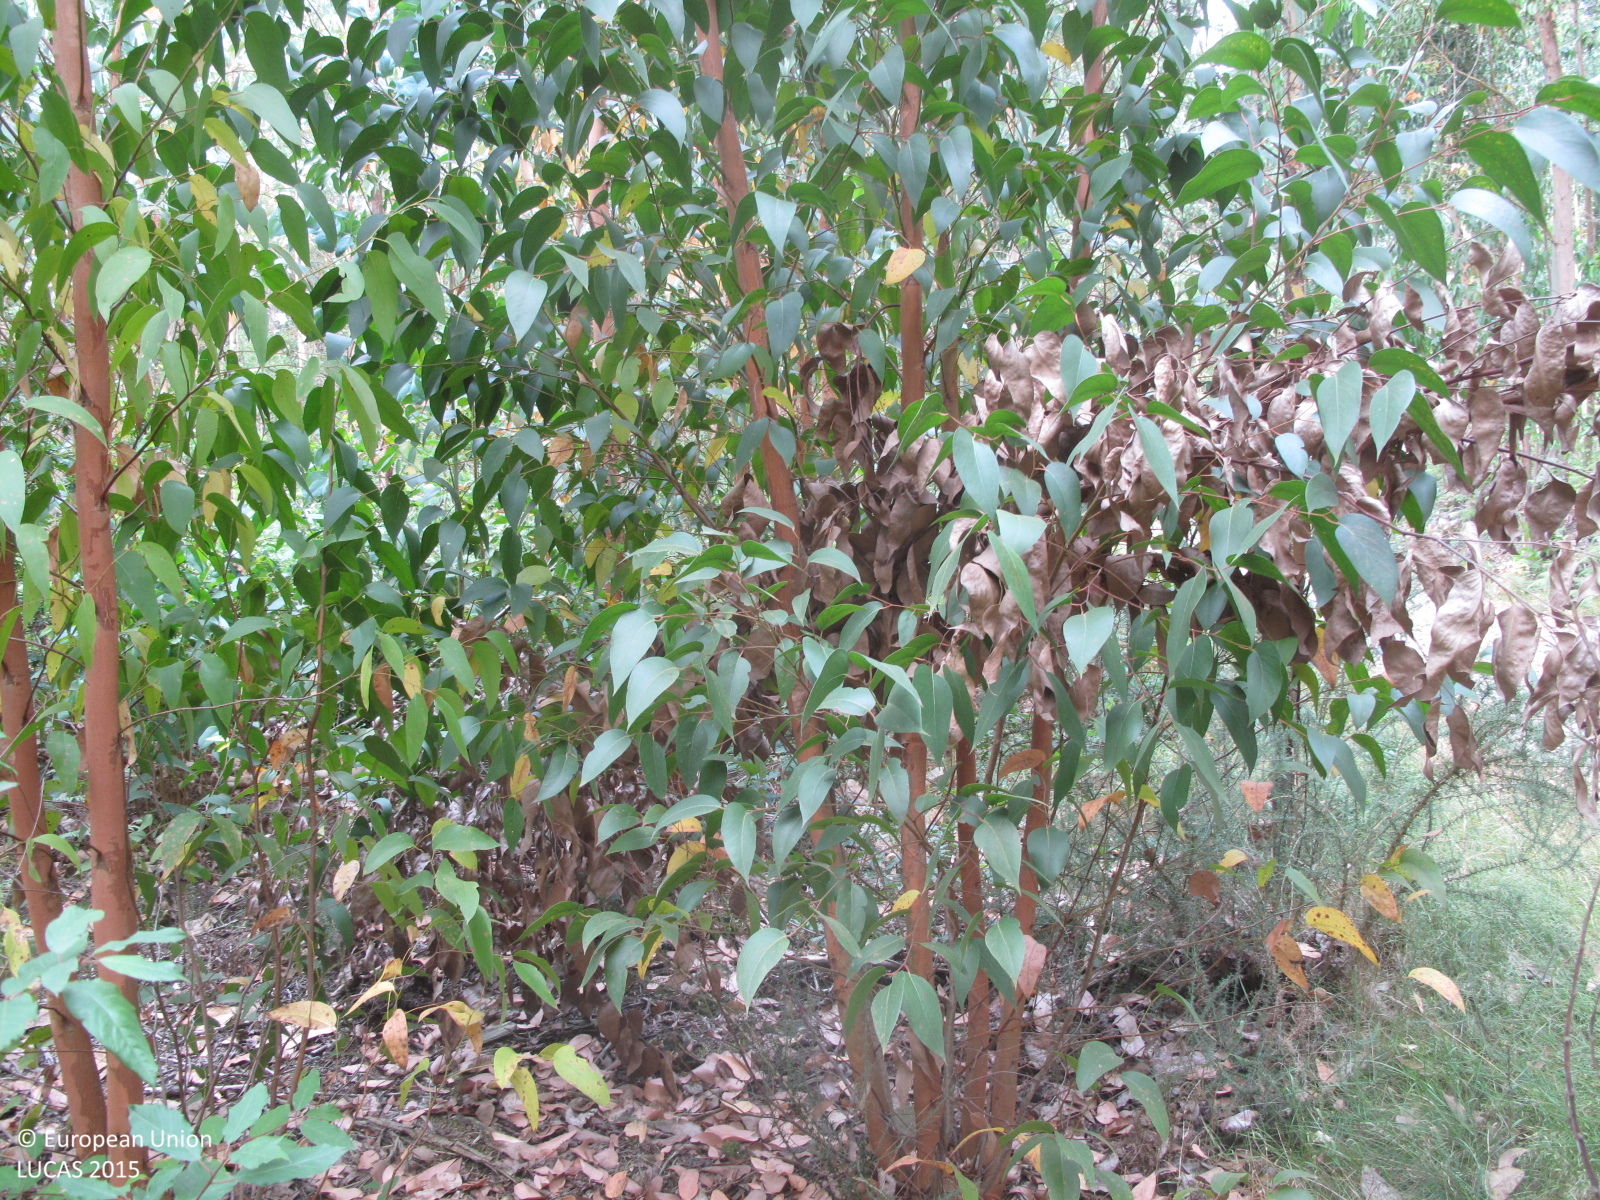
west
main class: Woodland
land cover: Broadleaved woodland
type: exotic forest
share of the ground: 50 - 75 %
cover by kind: broadleaved forest trees 60 %, herbaceous plants 20 %, shrubs 10 %, unconsolidated bare surface 10 %
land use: Forestry
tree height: > 5 m
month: July
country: ES
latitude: 43.2645
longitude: -8.0697
